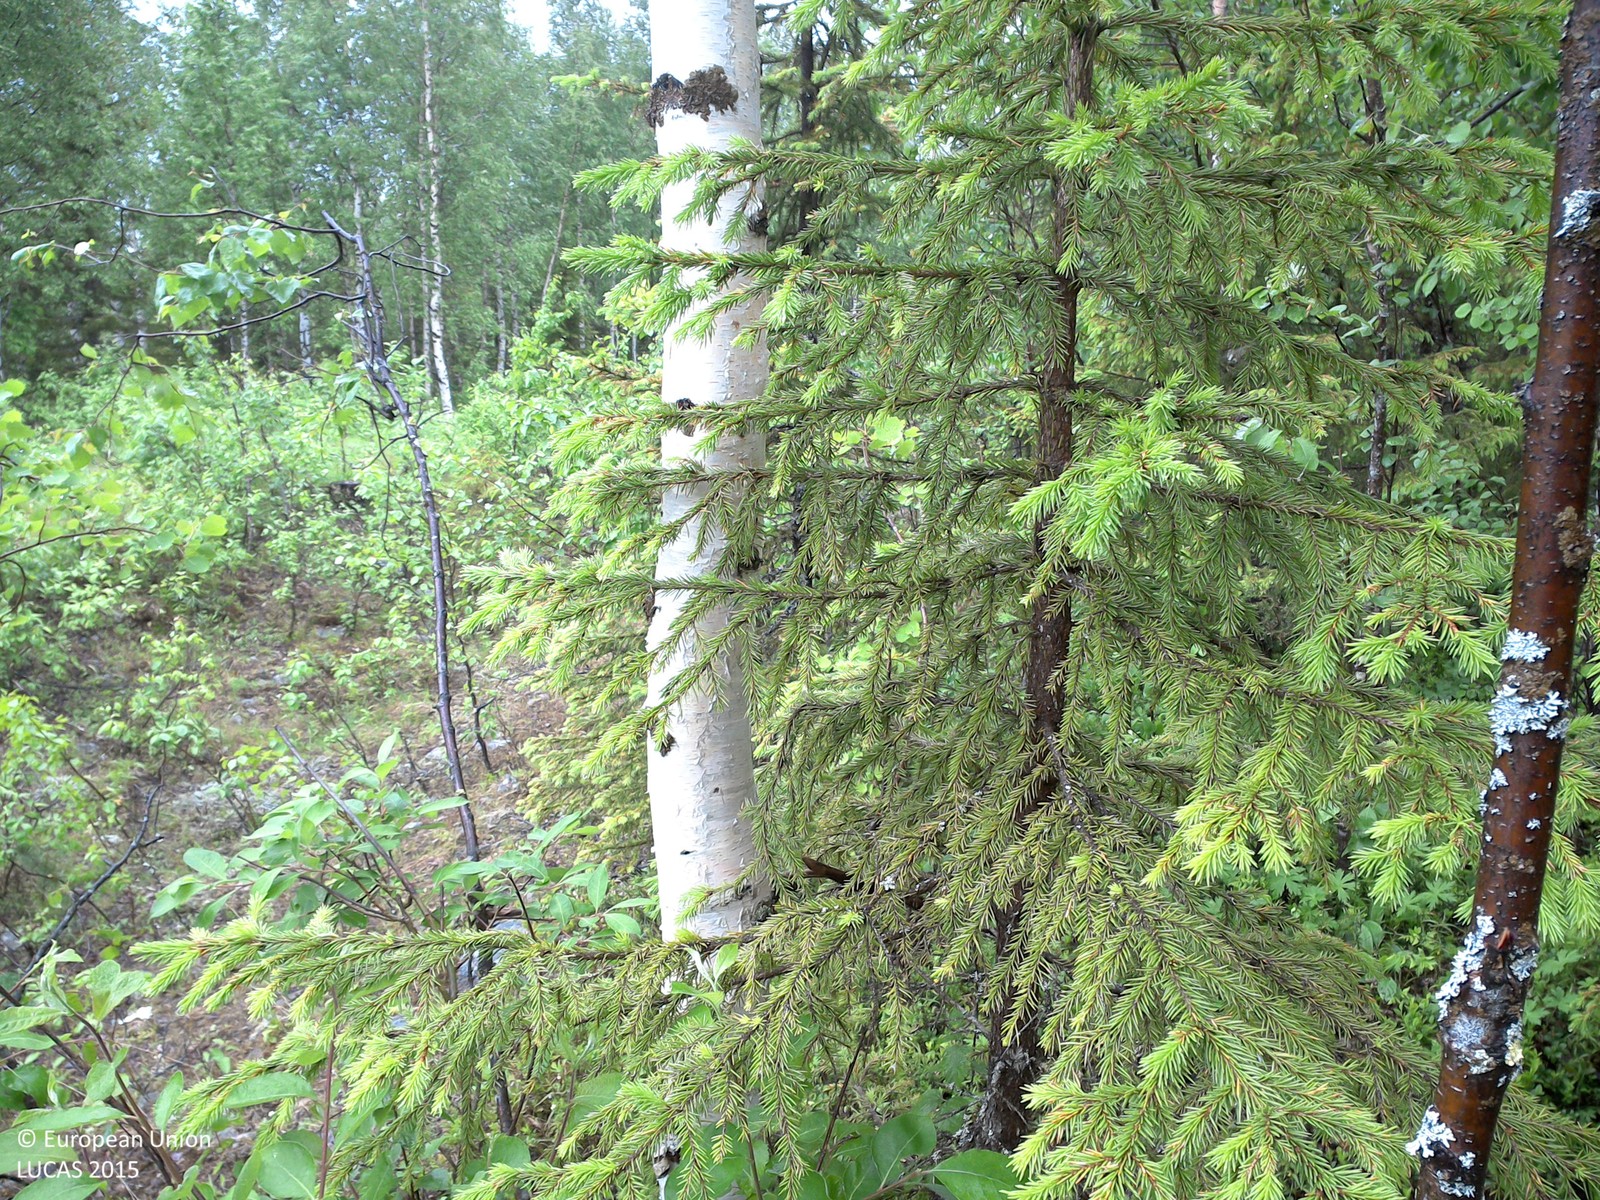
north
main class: Woodland
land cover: Other mixed woodland
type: boreal forest
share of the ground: 25 - 50 %
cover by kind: shrubs 55 %, broadleaved forest trees 20 %, herbaceous plants 15 %, coniferous forest trees 10 %
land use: Forestry
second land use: Amenities, museums, leisure
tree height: > 5 m
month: July
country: SE
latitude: 66.6643
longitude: 23.3499
